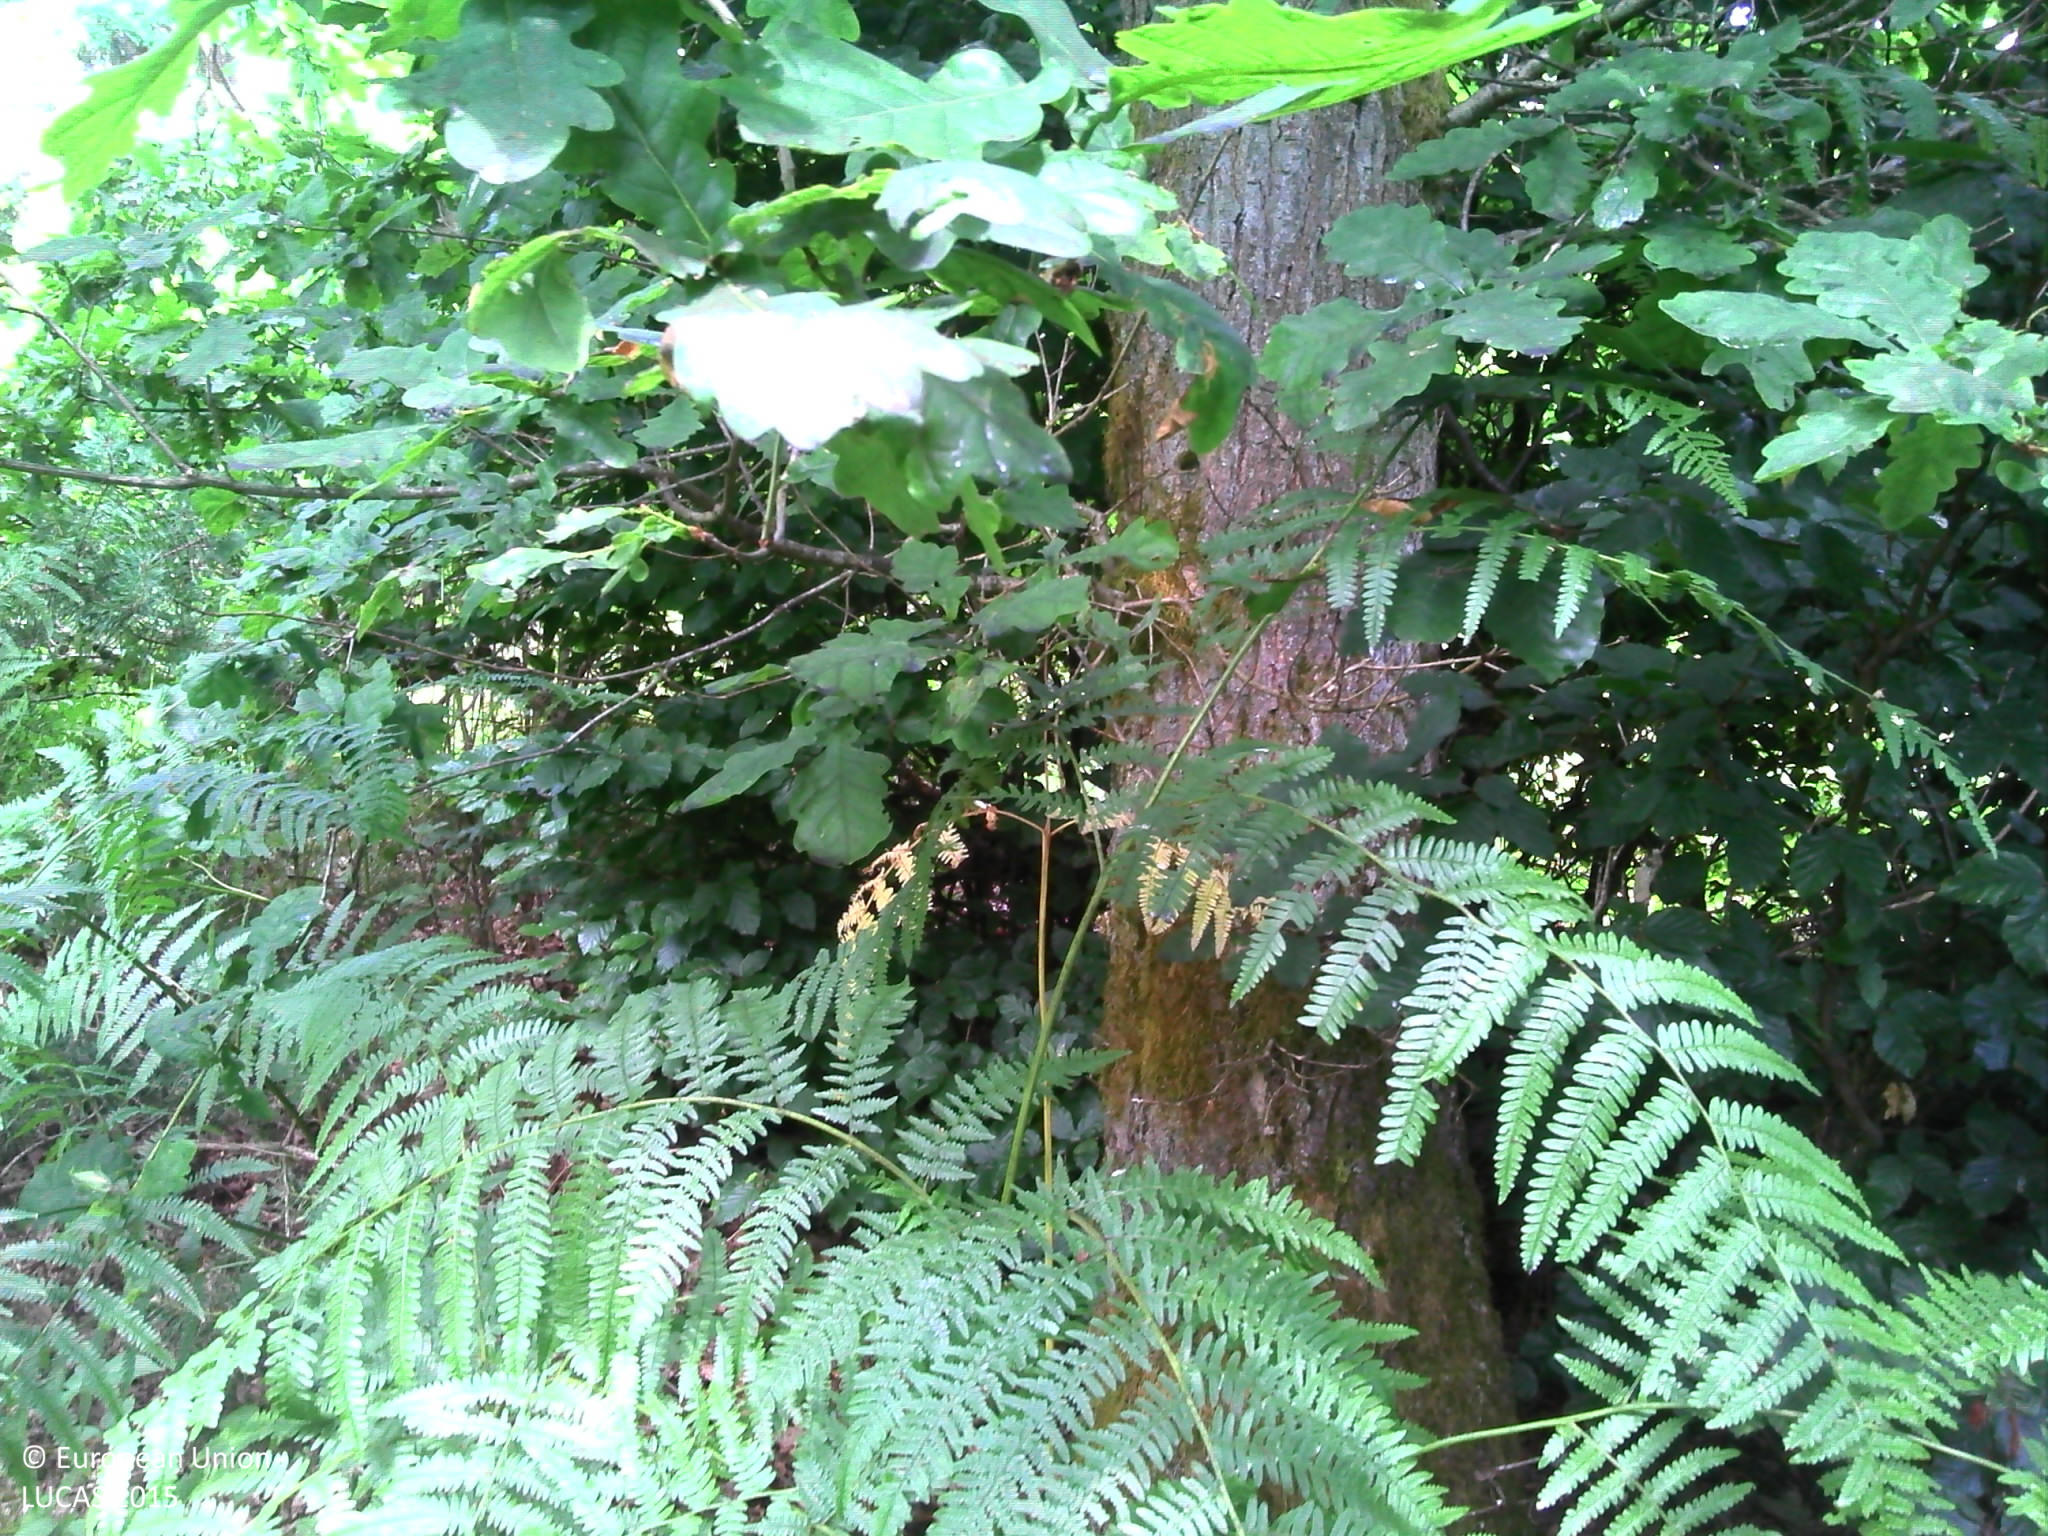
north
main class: Woodland
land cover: Broadleaved woodland
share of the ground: 50 - 75 %
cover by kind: broadleaved forest trees 60 %, herbaceous plants 30 %, shrubs 10 %
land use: Forestry
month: July
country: BE
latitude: 49.9619
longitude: 5.7750
